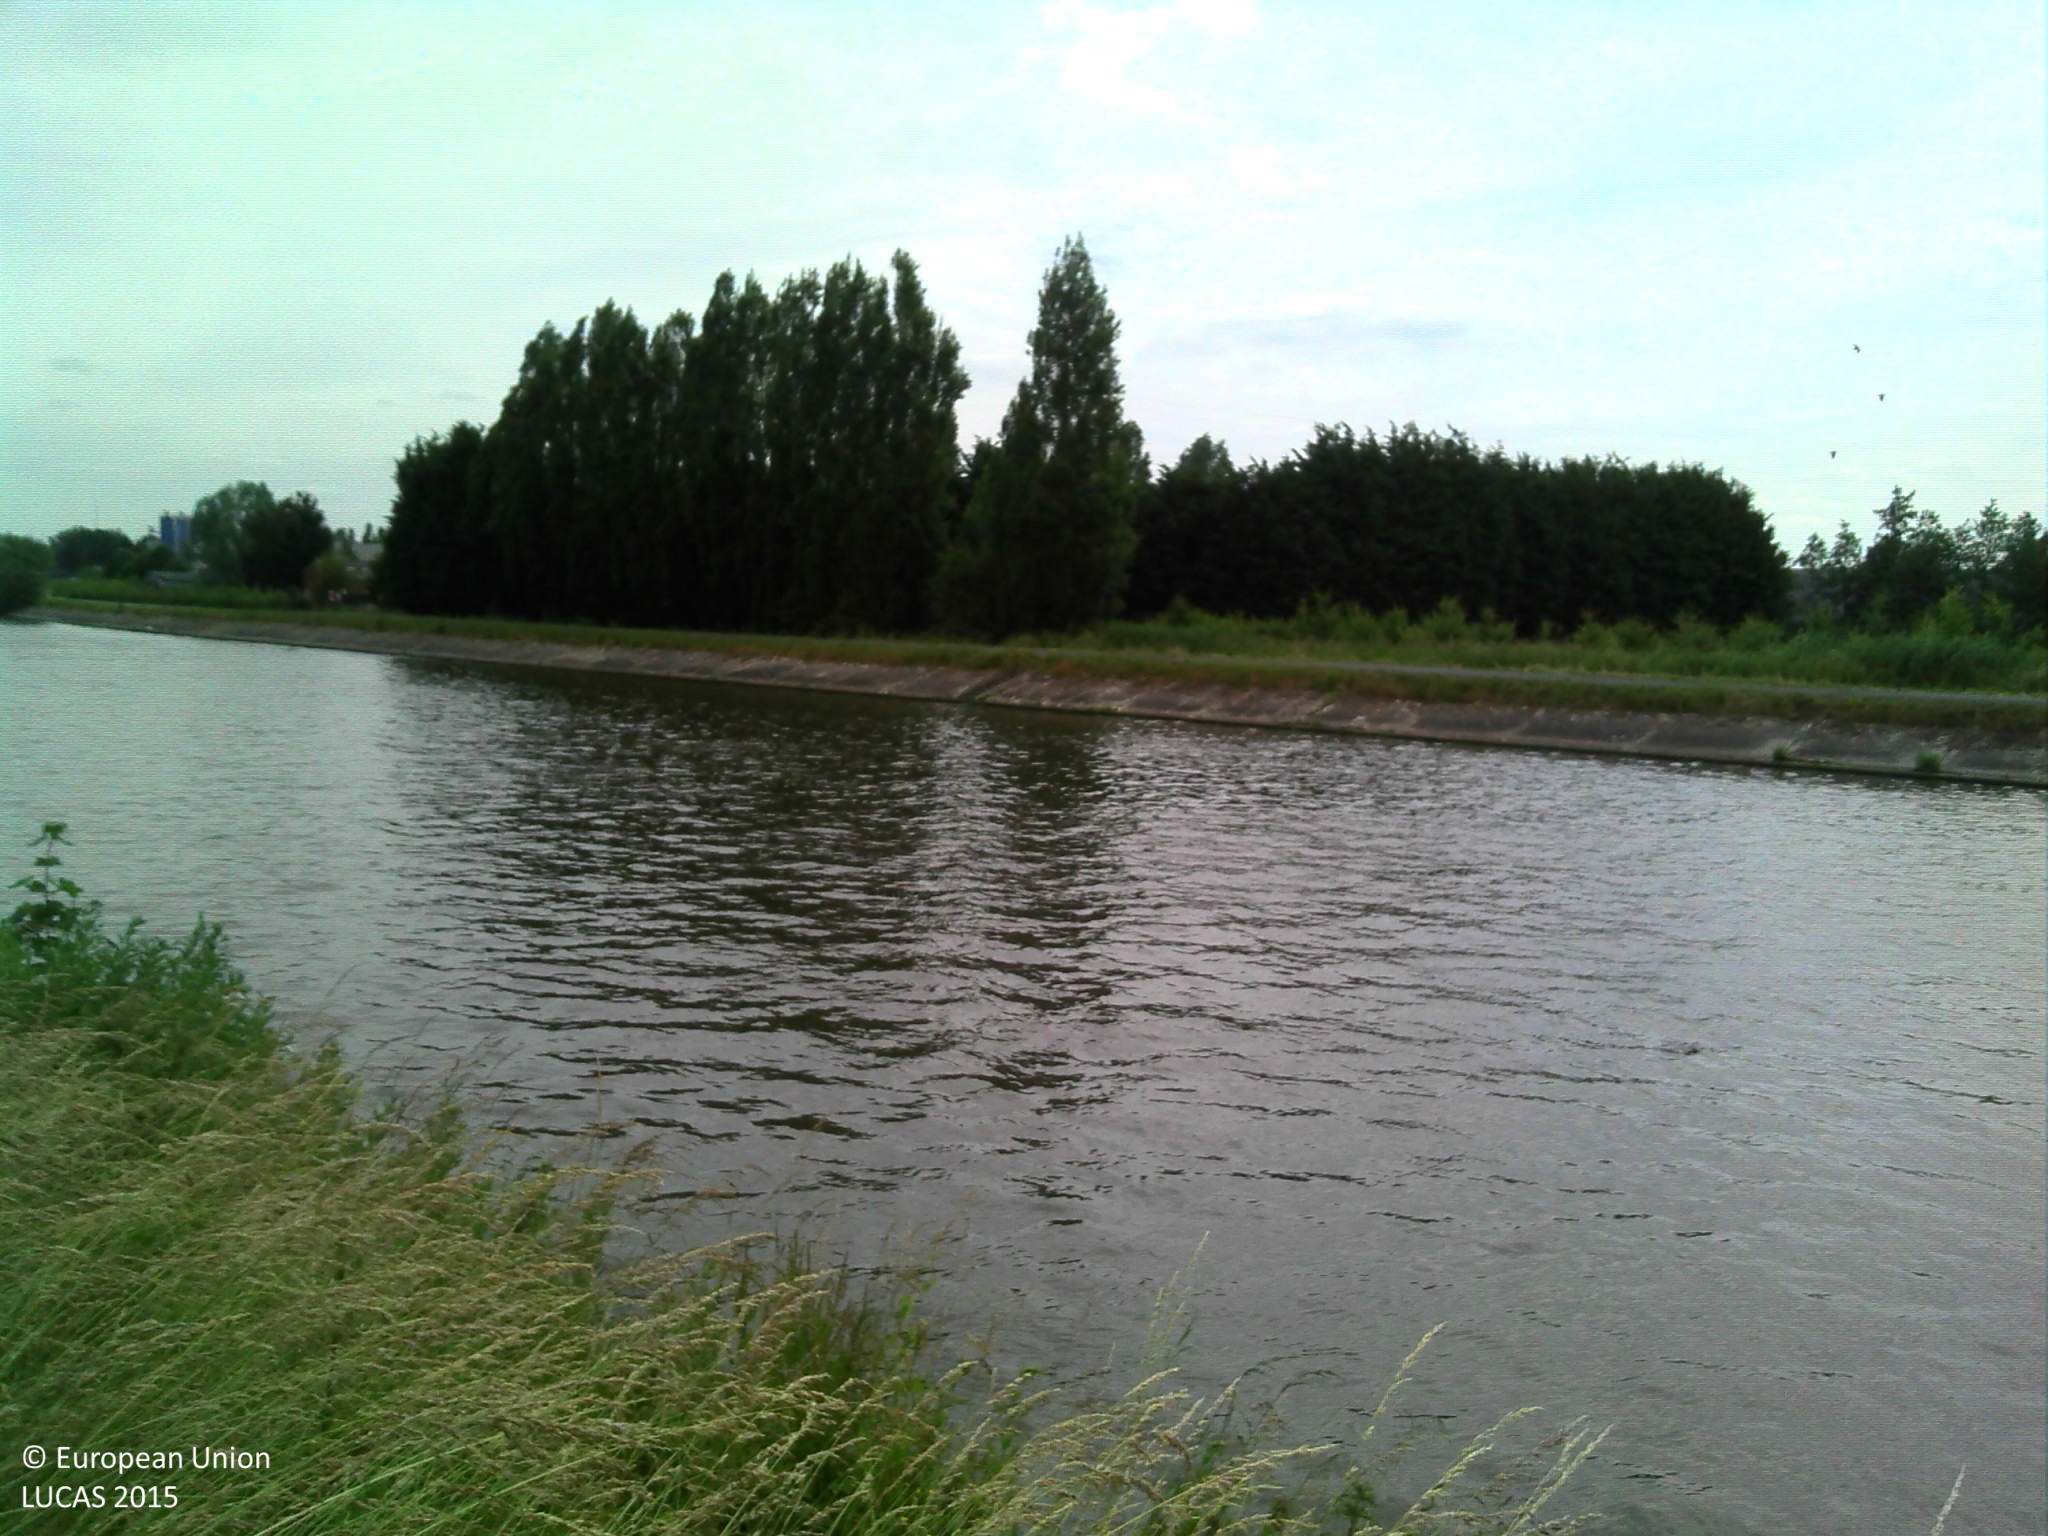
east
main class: Grassland
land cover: Spontaneously vegetated surfaces
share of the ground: > 75 %
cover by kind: herbaceous plants 100 %
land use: Semi-natural and natural areas not in use
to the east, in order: Inland fresh running water; Spontaneously vegetated surfaces; Tracks; Grassland without tree/shrub cover; Conifer hedges; Grassland without tree/shrub cover; Artificial constructions in urban areas; Grassland without tree/shrub cover; Artificial constructions in urban areas
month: June
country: BE
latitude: 50.8336
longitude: 3.5889
